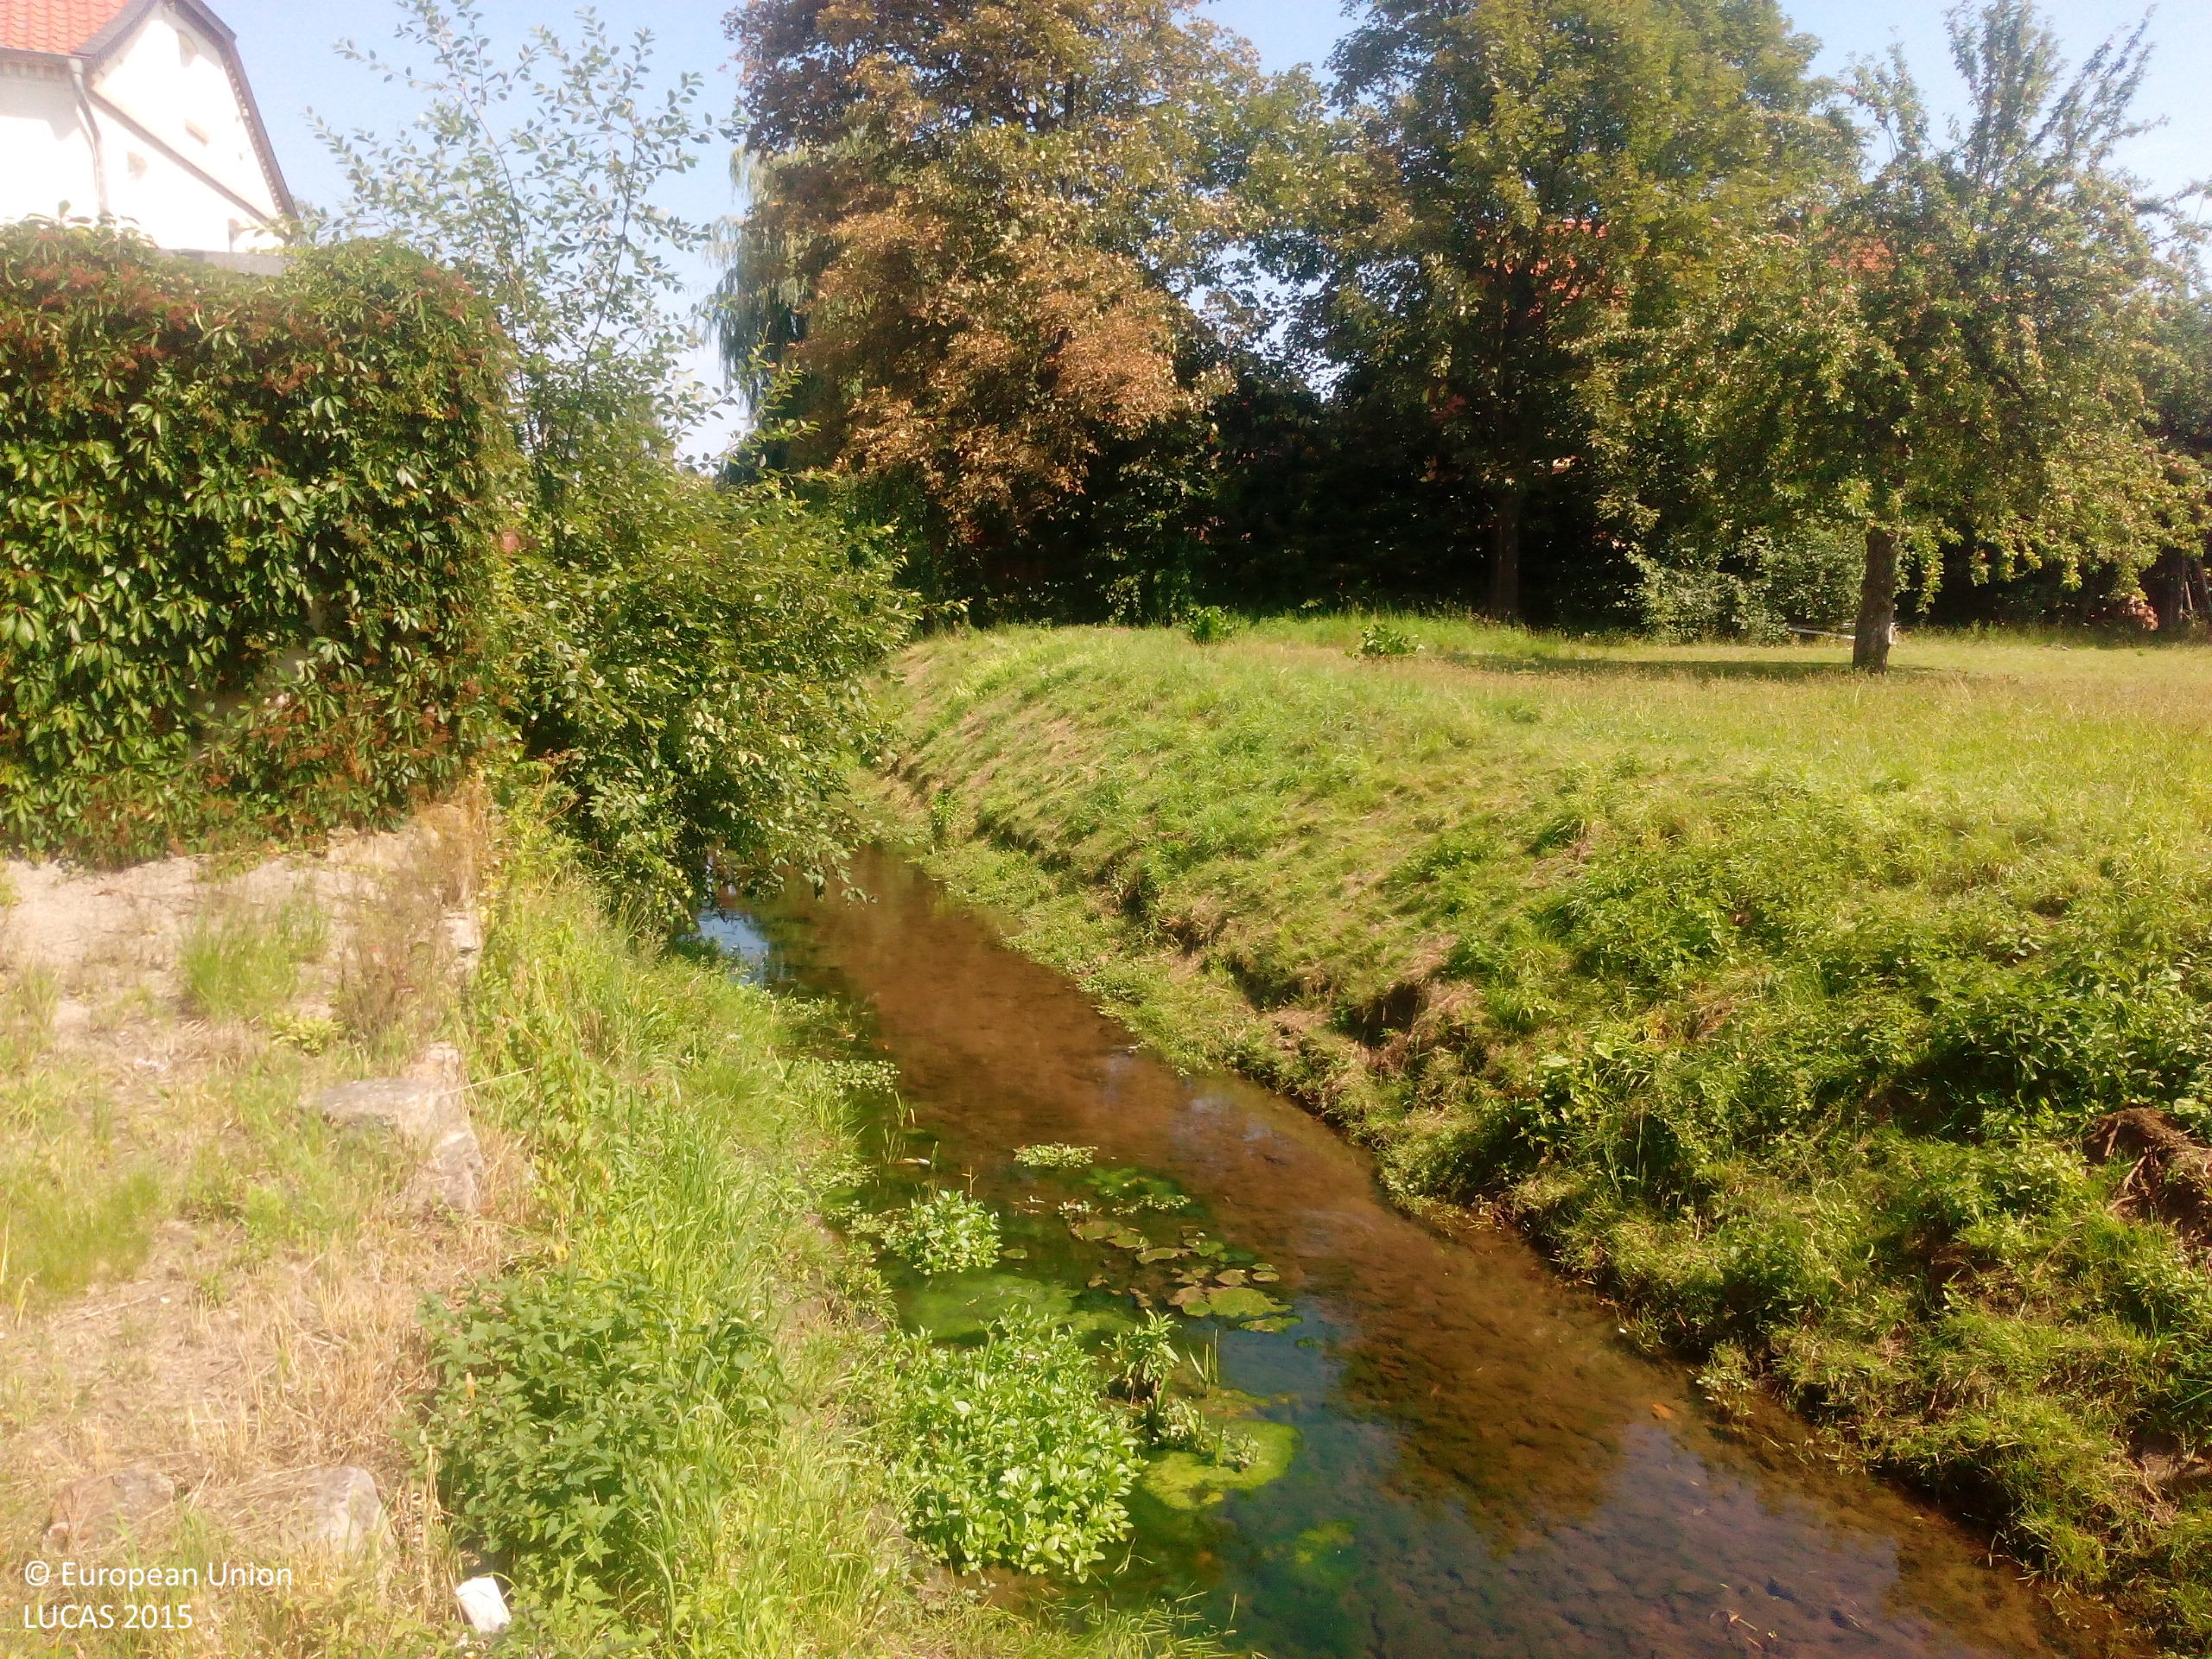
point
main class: Grassland
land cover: Grassland with sparse tree/shrub cover
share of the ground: > 75 %
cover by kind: herbaceous plants 95 %, broadleaved forest trees 5 %
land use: Residential
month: August
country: DE
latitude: 52.0845
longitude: 11.1233
